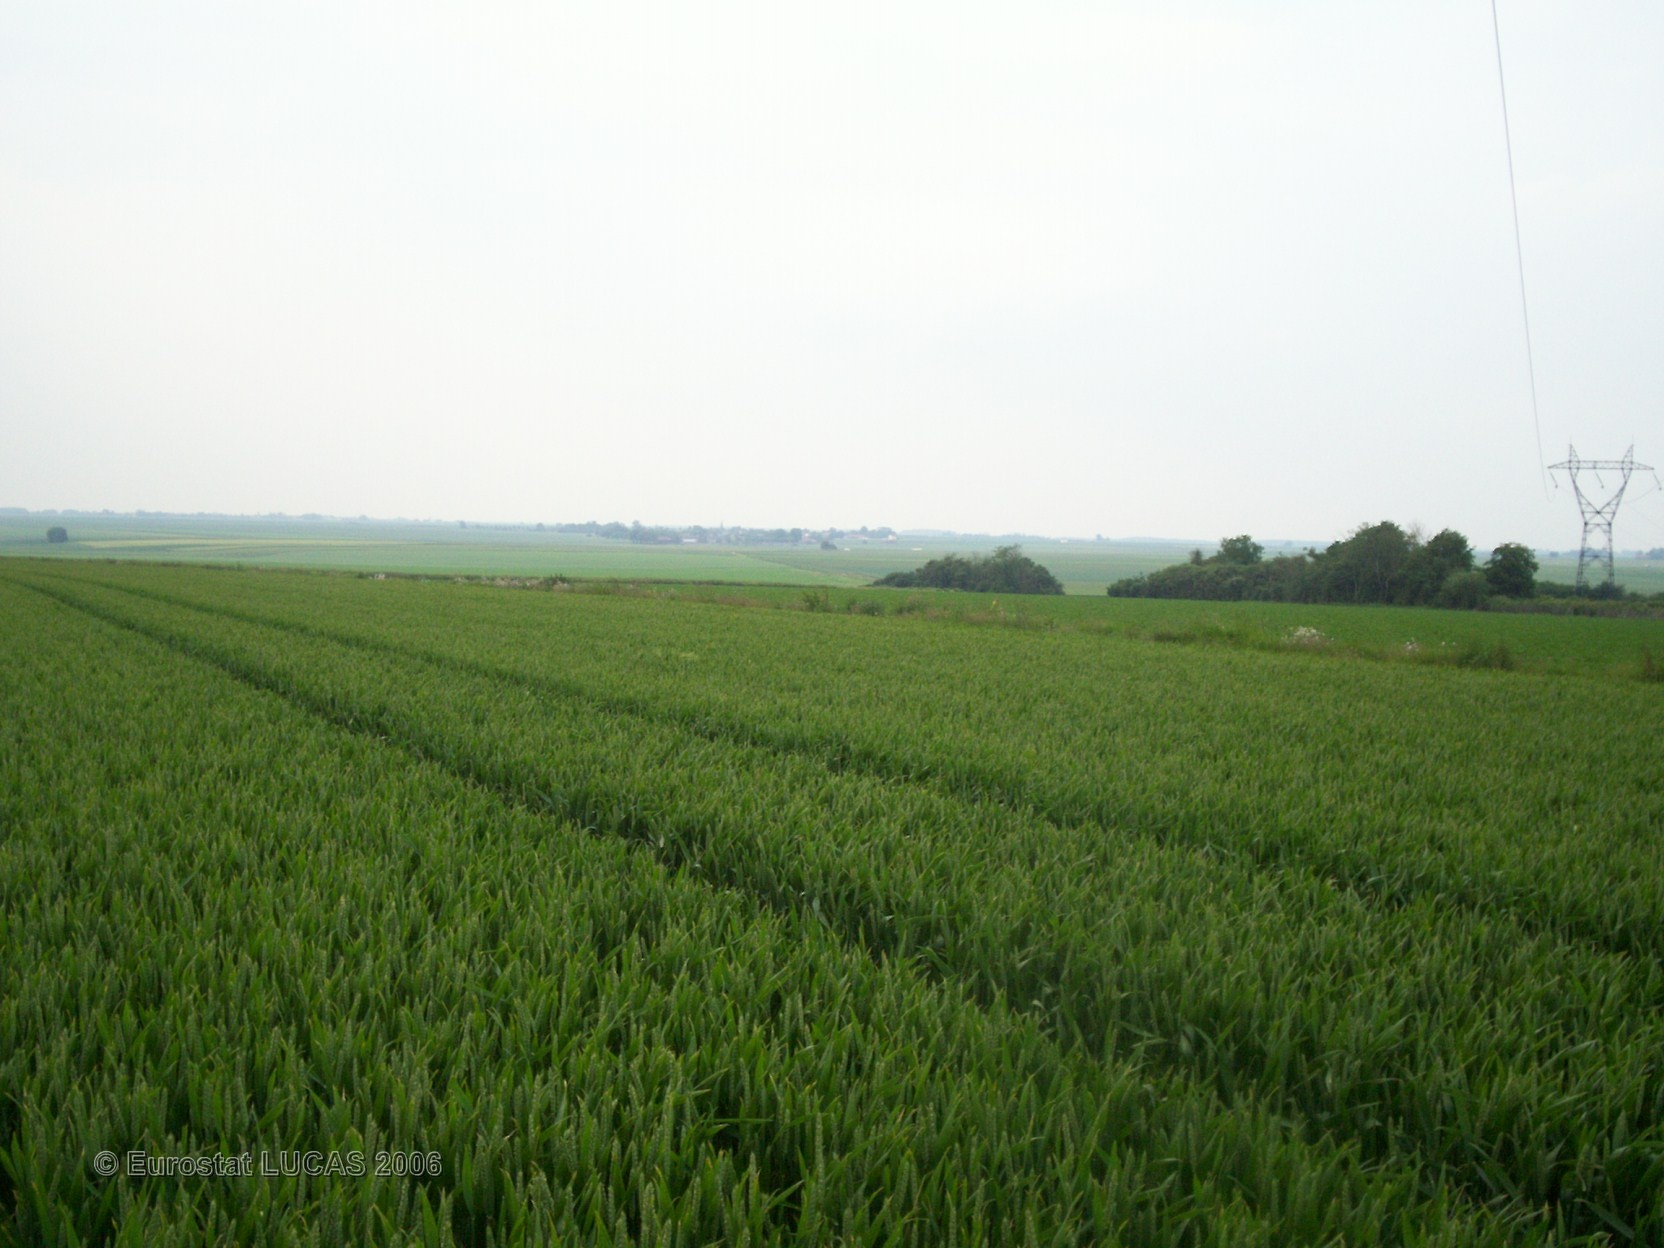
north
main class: Cropland
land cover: Common wheat
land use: Agriculture (excluding fallow land and kitchen gardens)
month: June
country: FR
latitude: 49.6032
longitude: 2.6411
